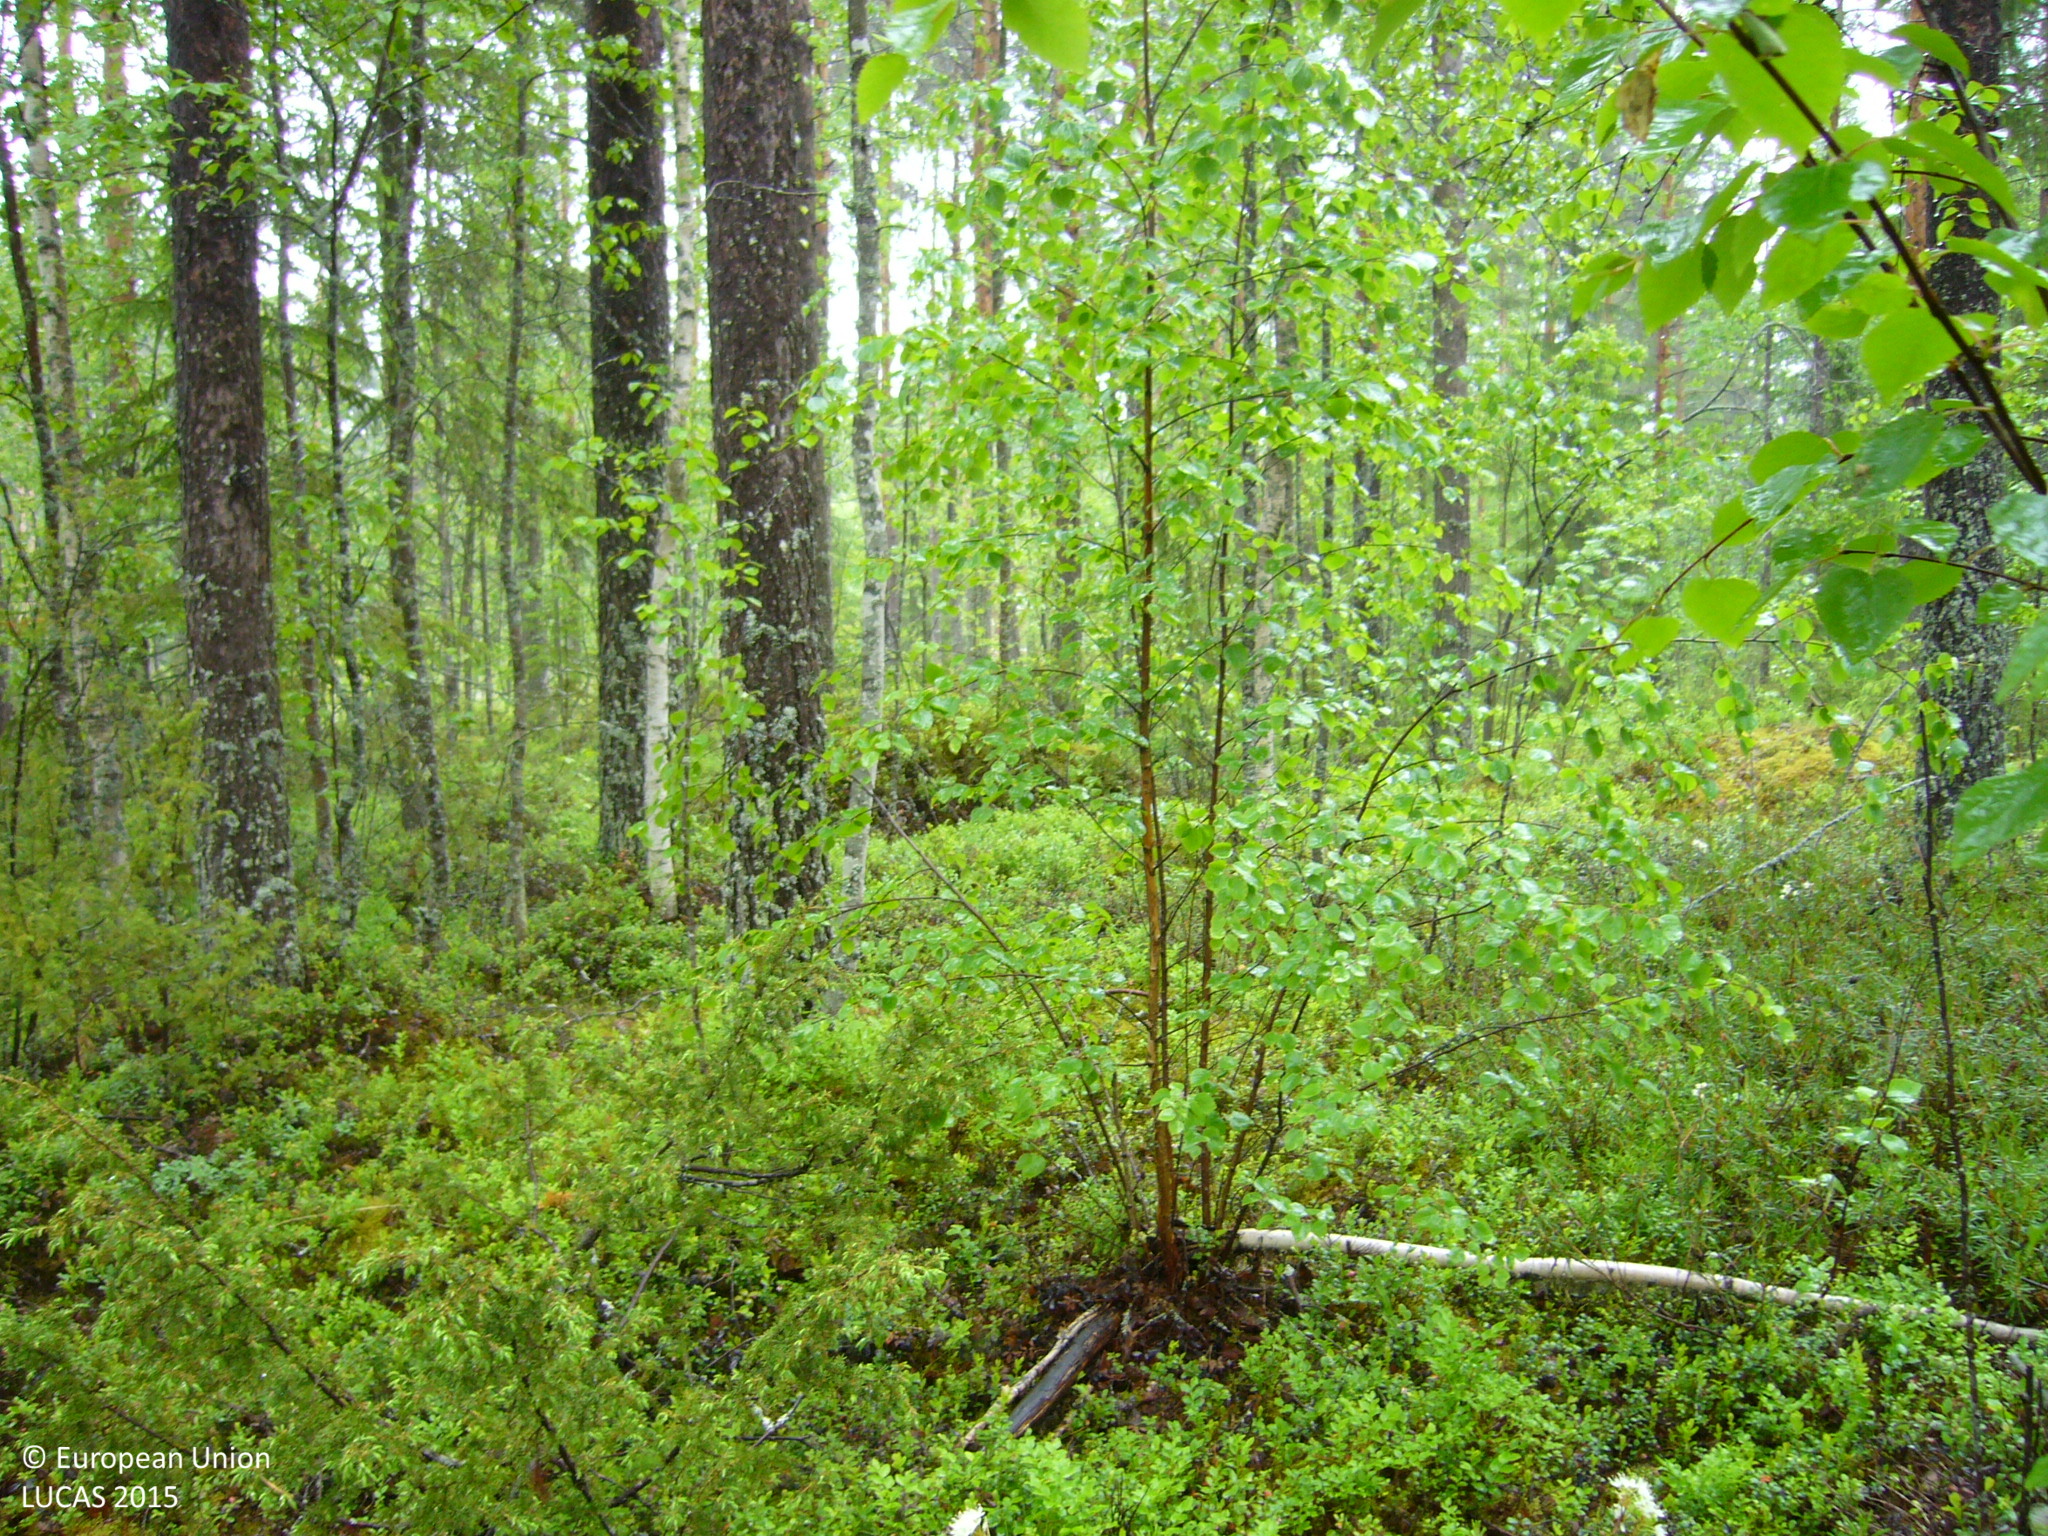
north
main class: Woodland
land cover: Pine dominated mixed woodland
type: boreal forest
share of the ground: 50 - 75 %
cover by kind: coniferous forest trees 40 %, shrubs 35 %, broadleaved forest trees 25 %
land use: Forestry
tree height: > 5 m
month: June
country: FI
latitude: 63.8036
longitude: 25.0517
